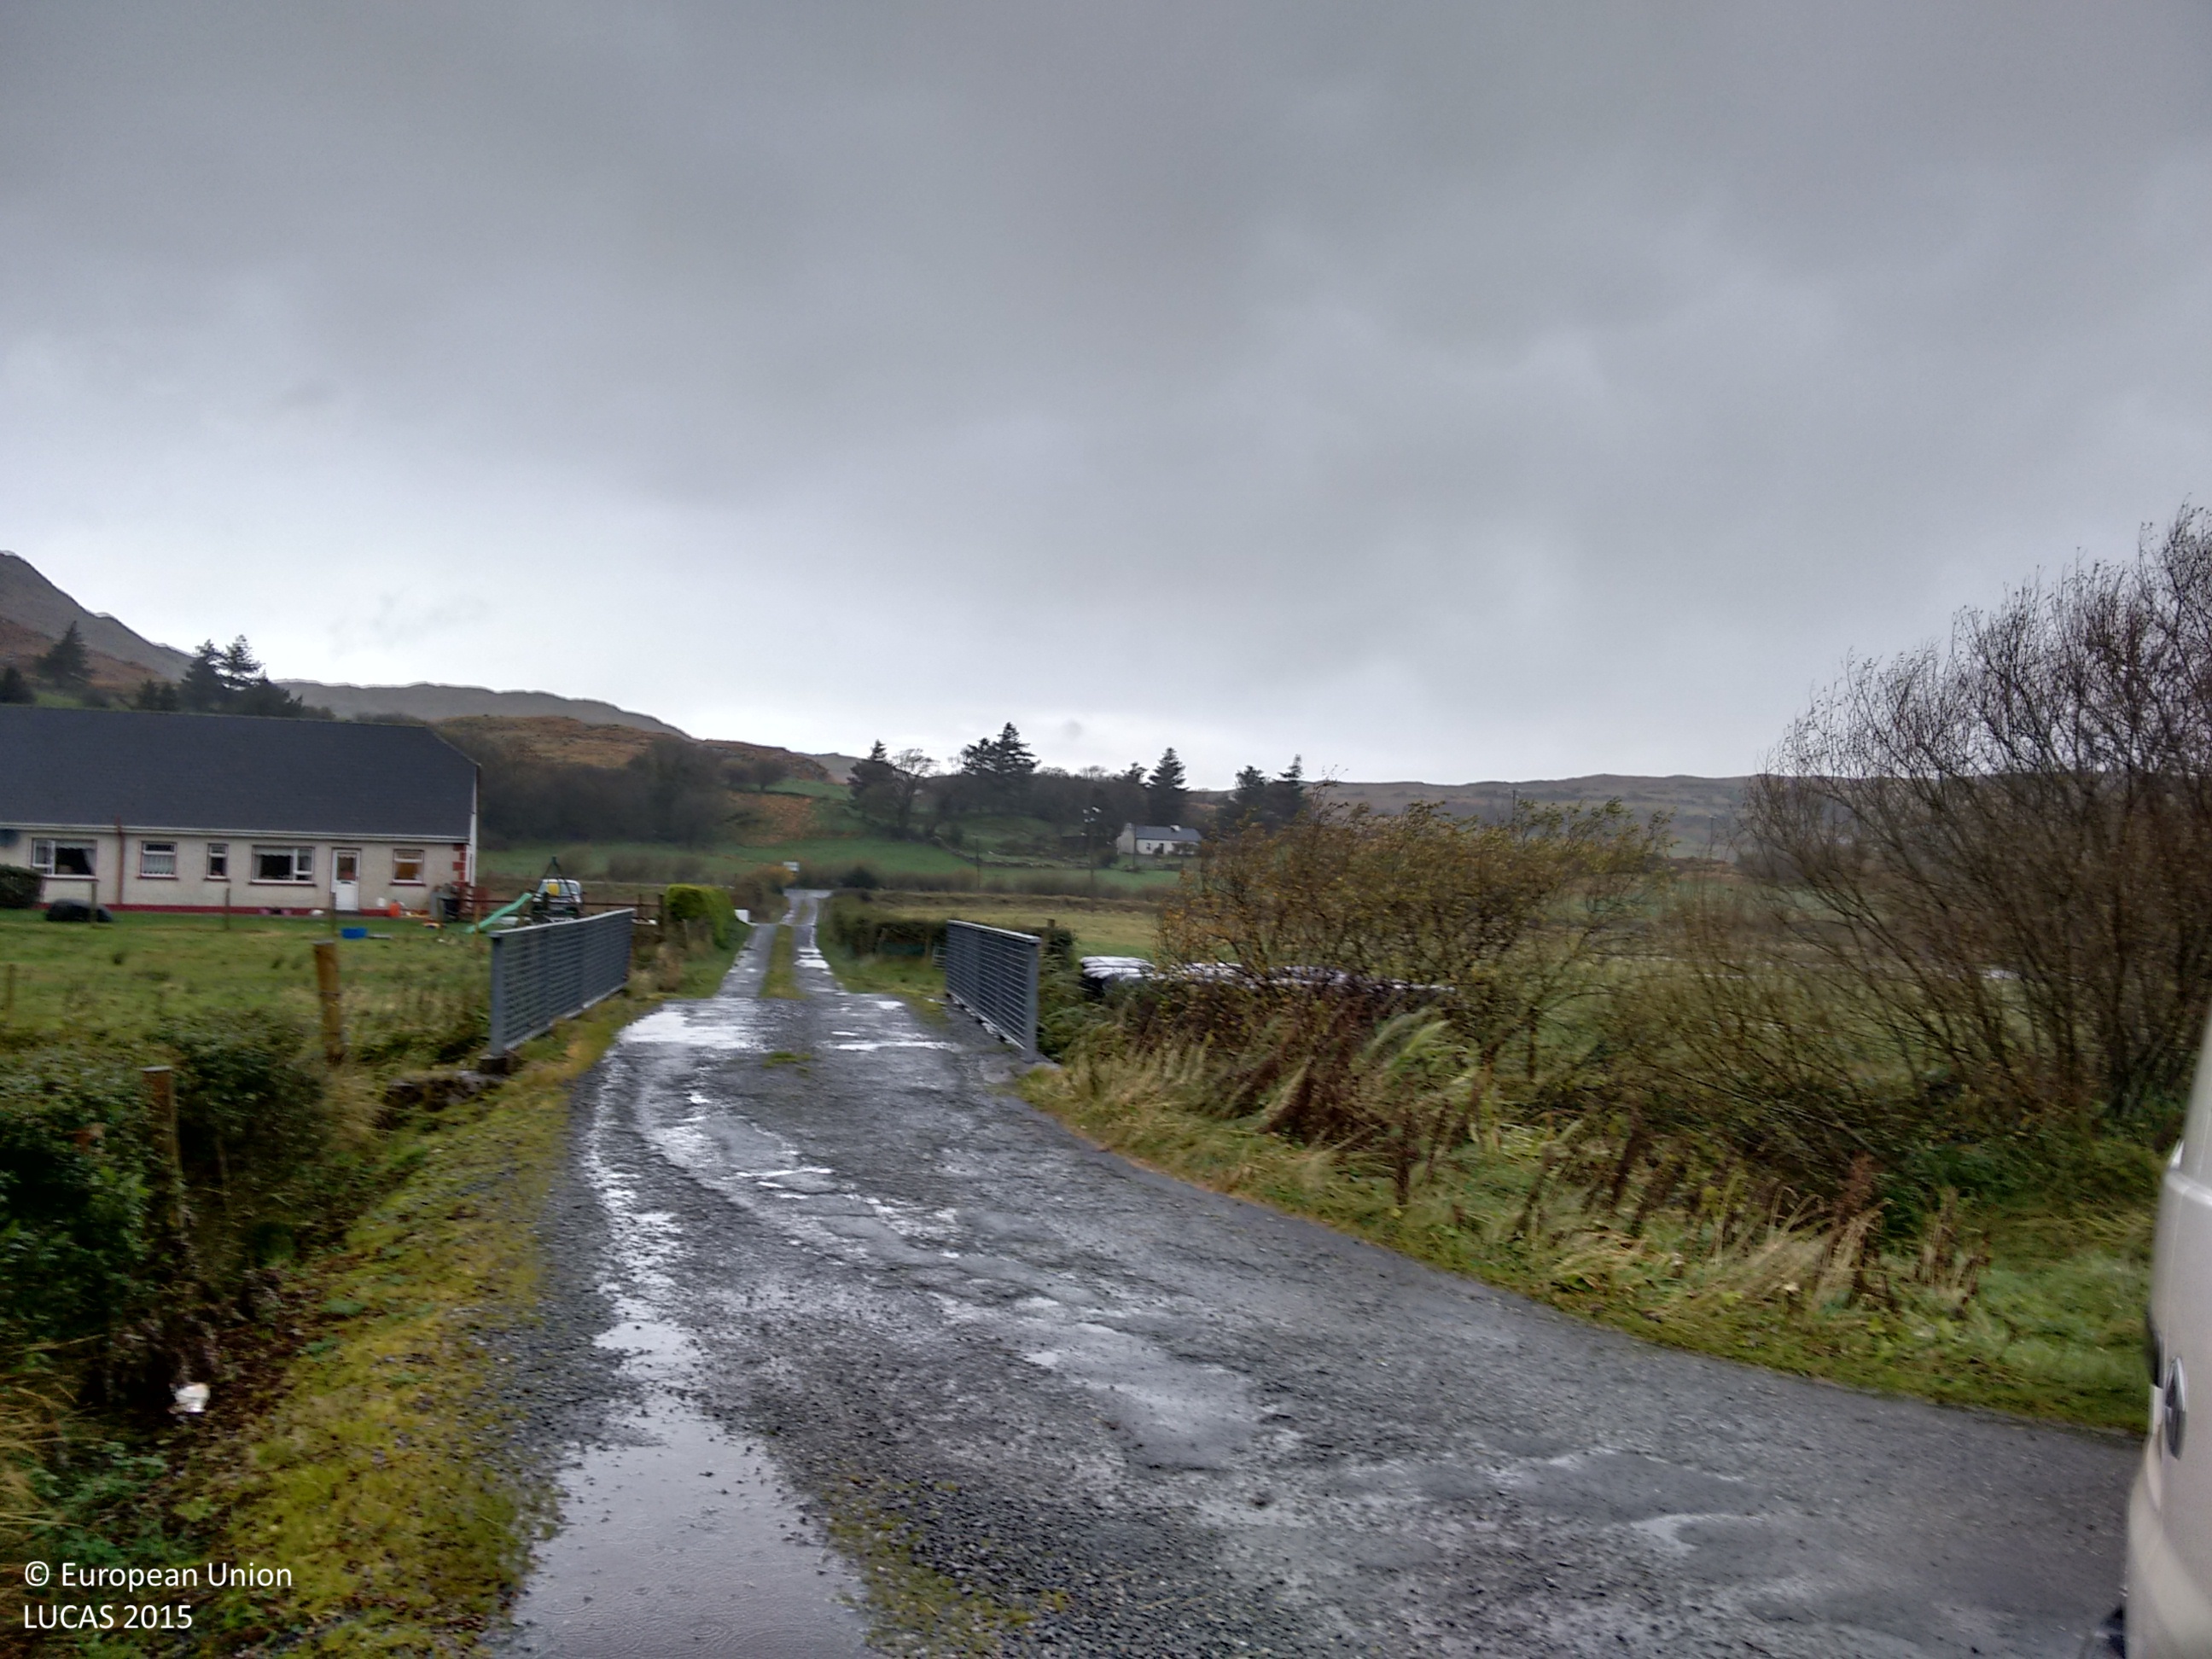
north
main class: Grassland
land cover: Grassland without tree/shrub cover
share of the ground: > 75 %
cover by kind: herbaceous plants 80 %, lichens and mosses 20 %
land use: Agriculture (excluding fallow land and kitchen gardens)
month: November
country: IE
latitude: 54.7403
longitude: -8.4391
